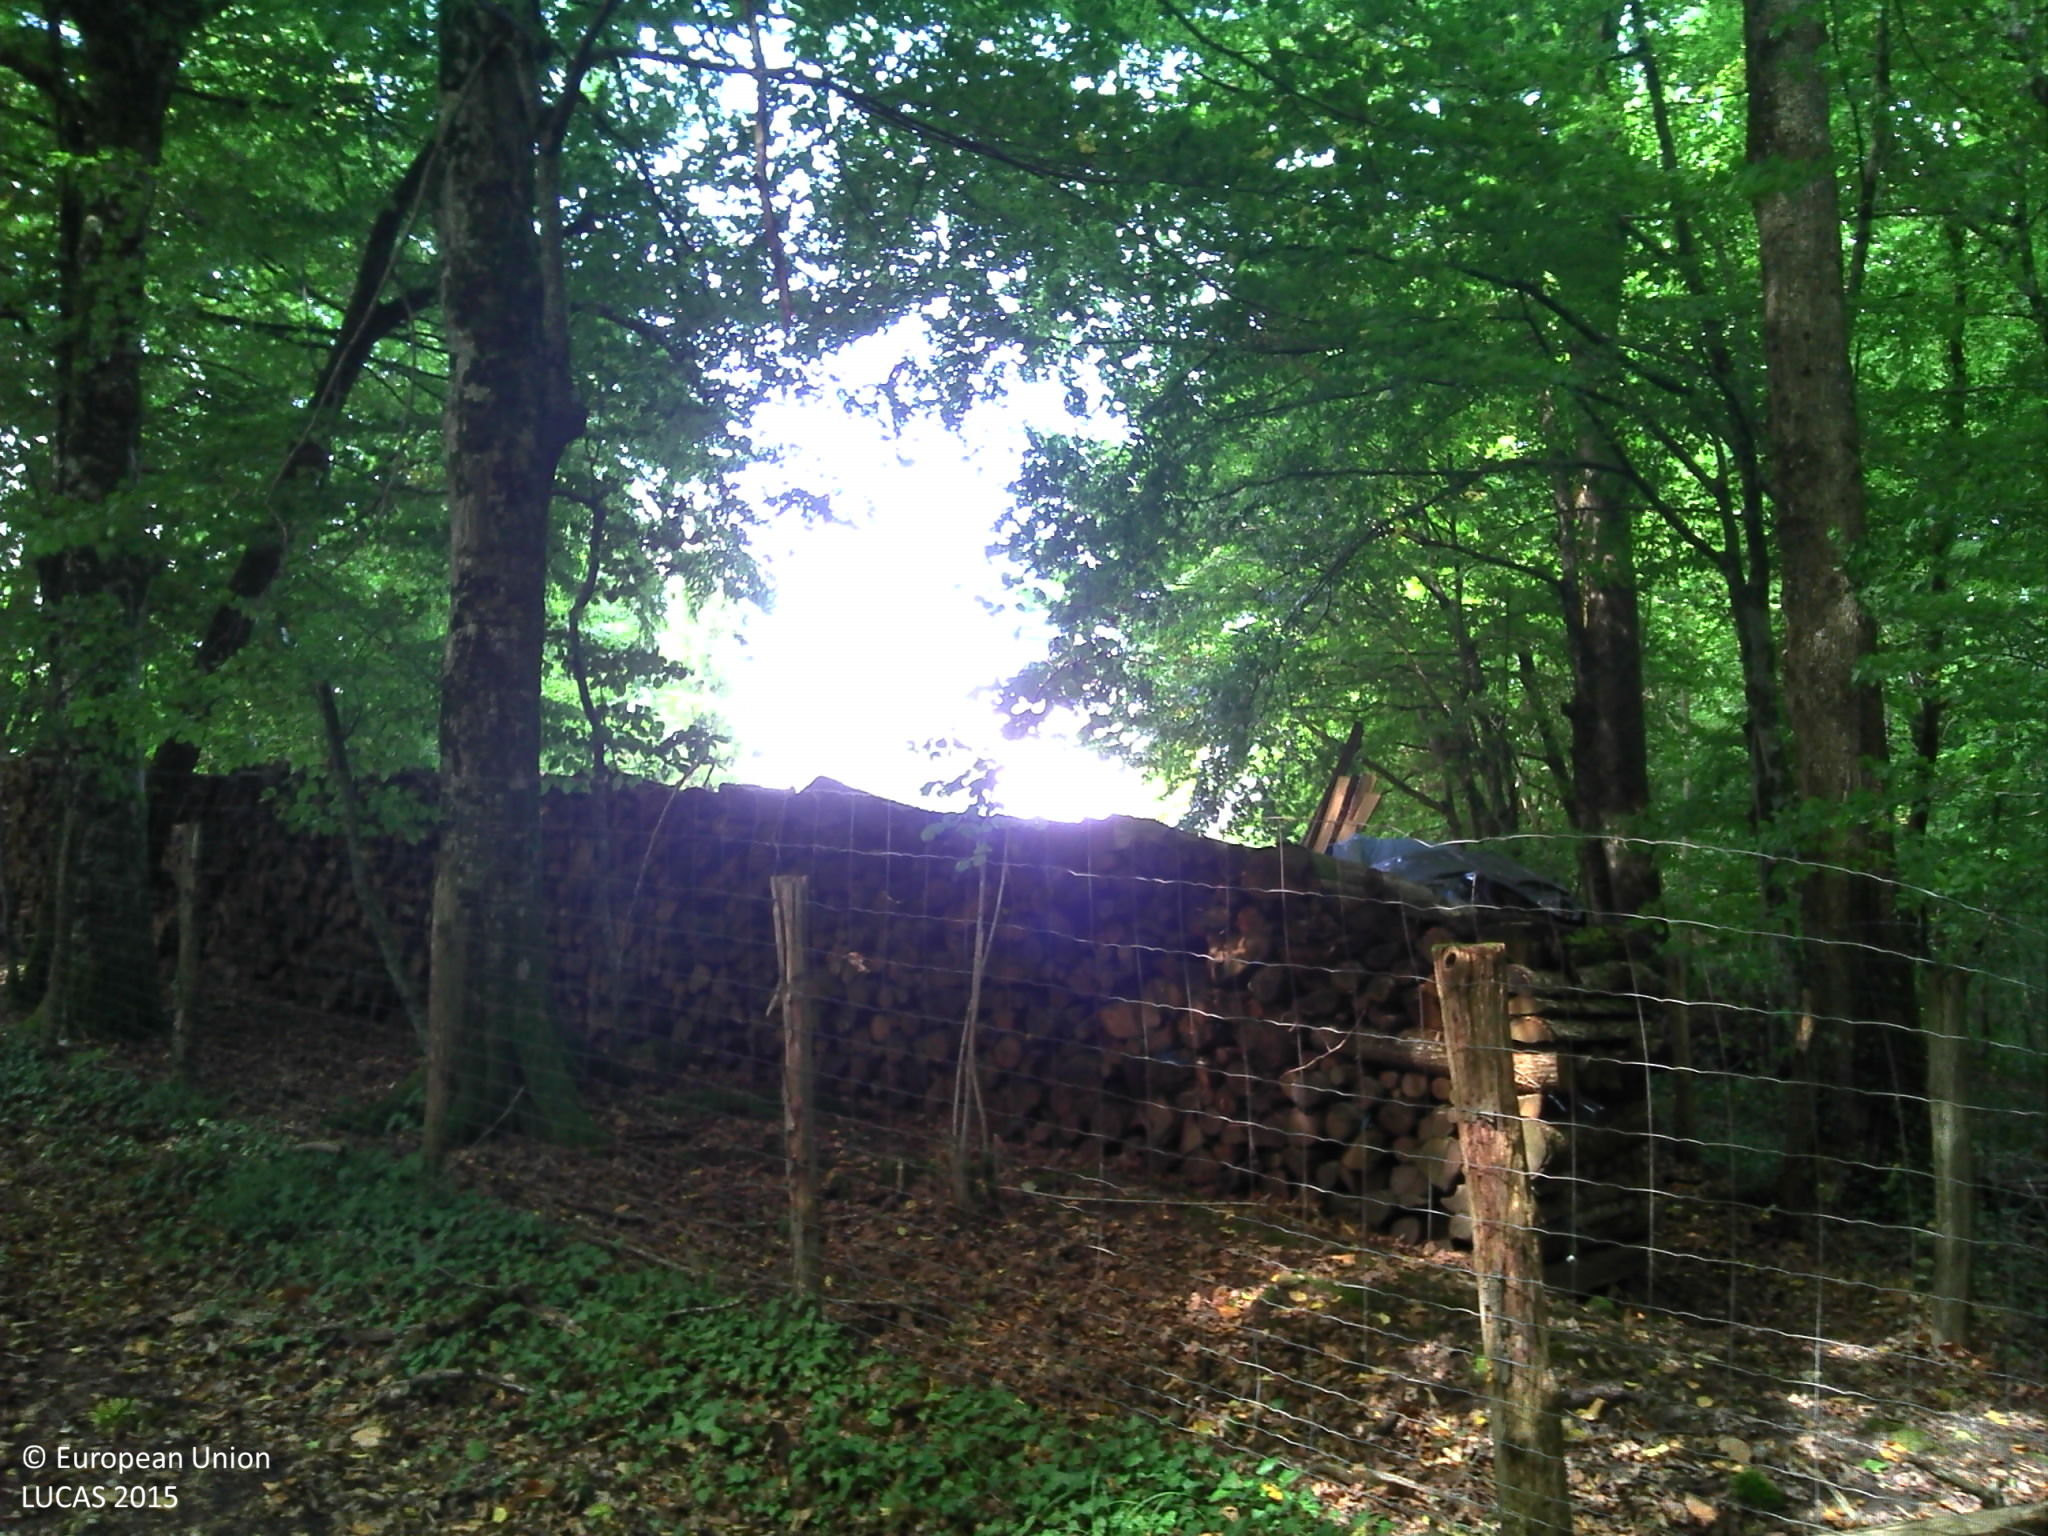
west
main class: Woodland
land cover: Broadleaved woodland
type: mesophytic deciduous forest
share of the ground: > 75 %
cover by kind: broadleaved forest trees 85 %, unconsolidated bare surface 10 %, herbaceous plants 5 %
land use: Forestry
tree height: > 5 m
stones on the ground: < 10 %
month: August
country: FR
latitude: 45.3077
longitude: 0.6658
